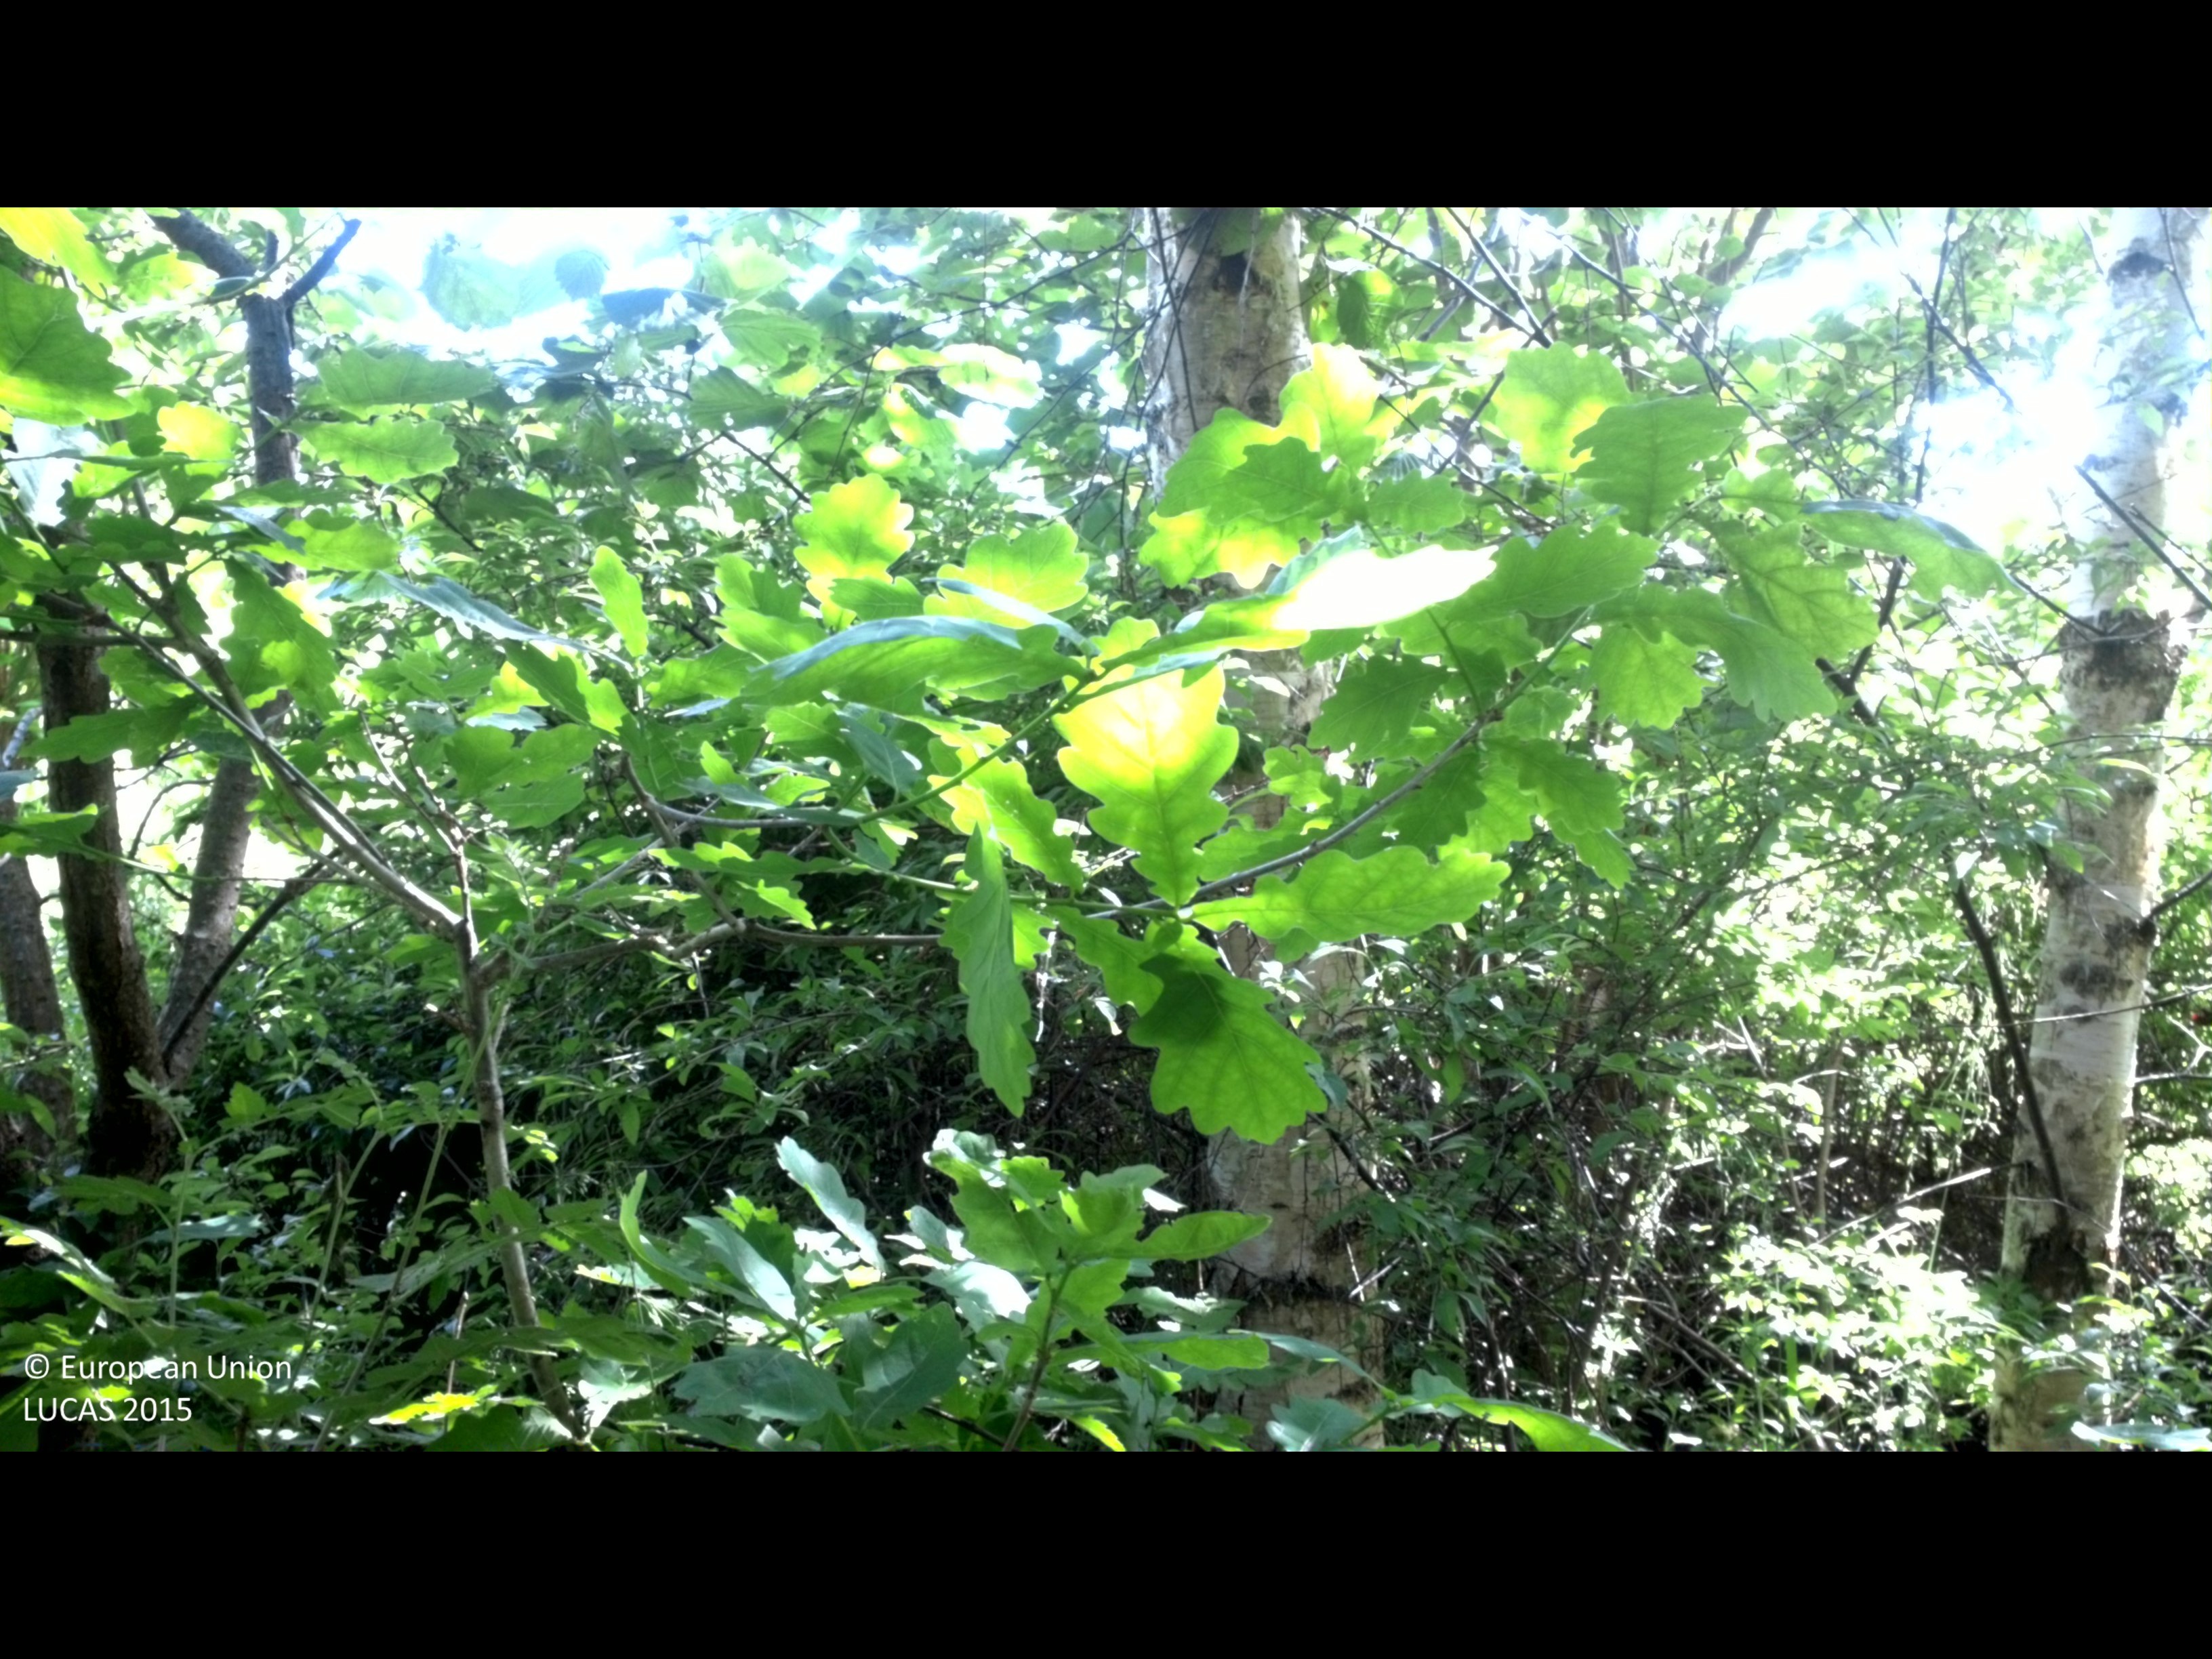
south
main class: Woodland
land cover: Broadleaved woodland
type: hemiboreal forest and nemoral coniferous forest and mixed broadleaved-coniferous forest
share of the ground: 25 - 50 %
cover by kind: shrubs 45 %, broadleaved forest trees 40 %, herbaceous plants 15 %
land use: Forestry
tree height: > 5 m
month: June
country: SE
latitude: 57.8918
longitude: 16.6615
